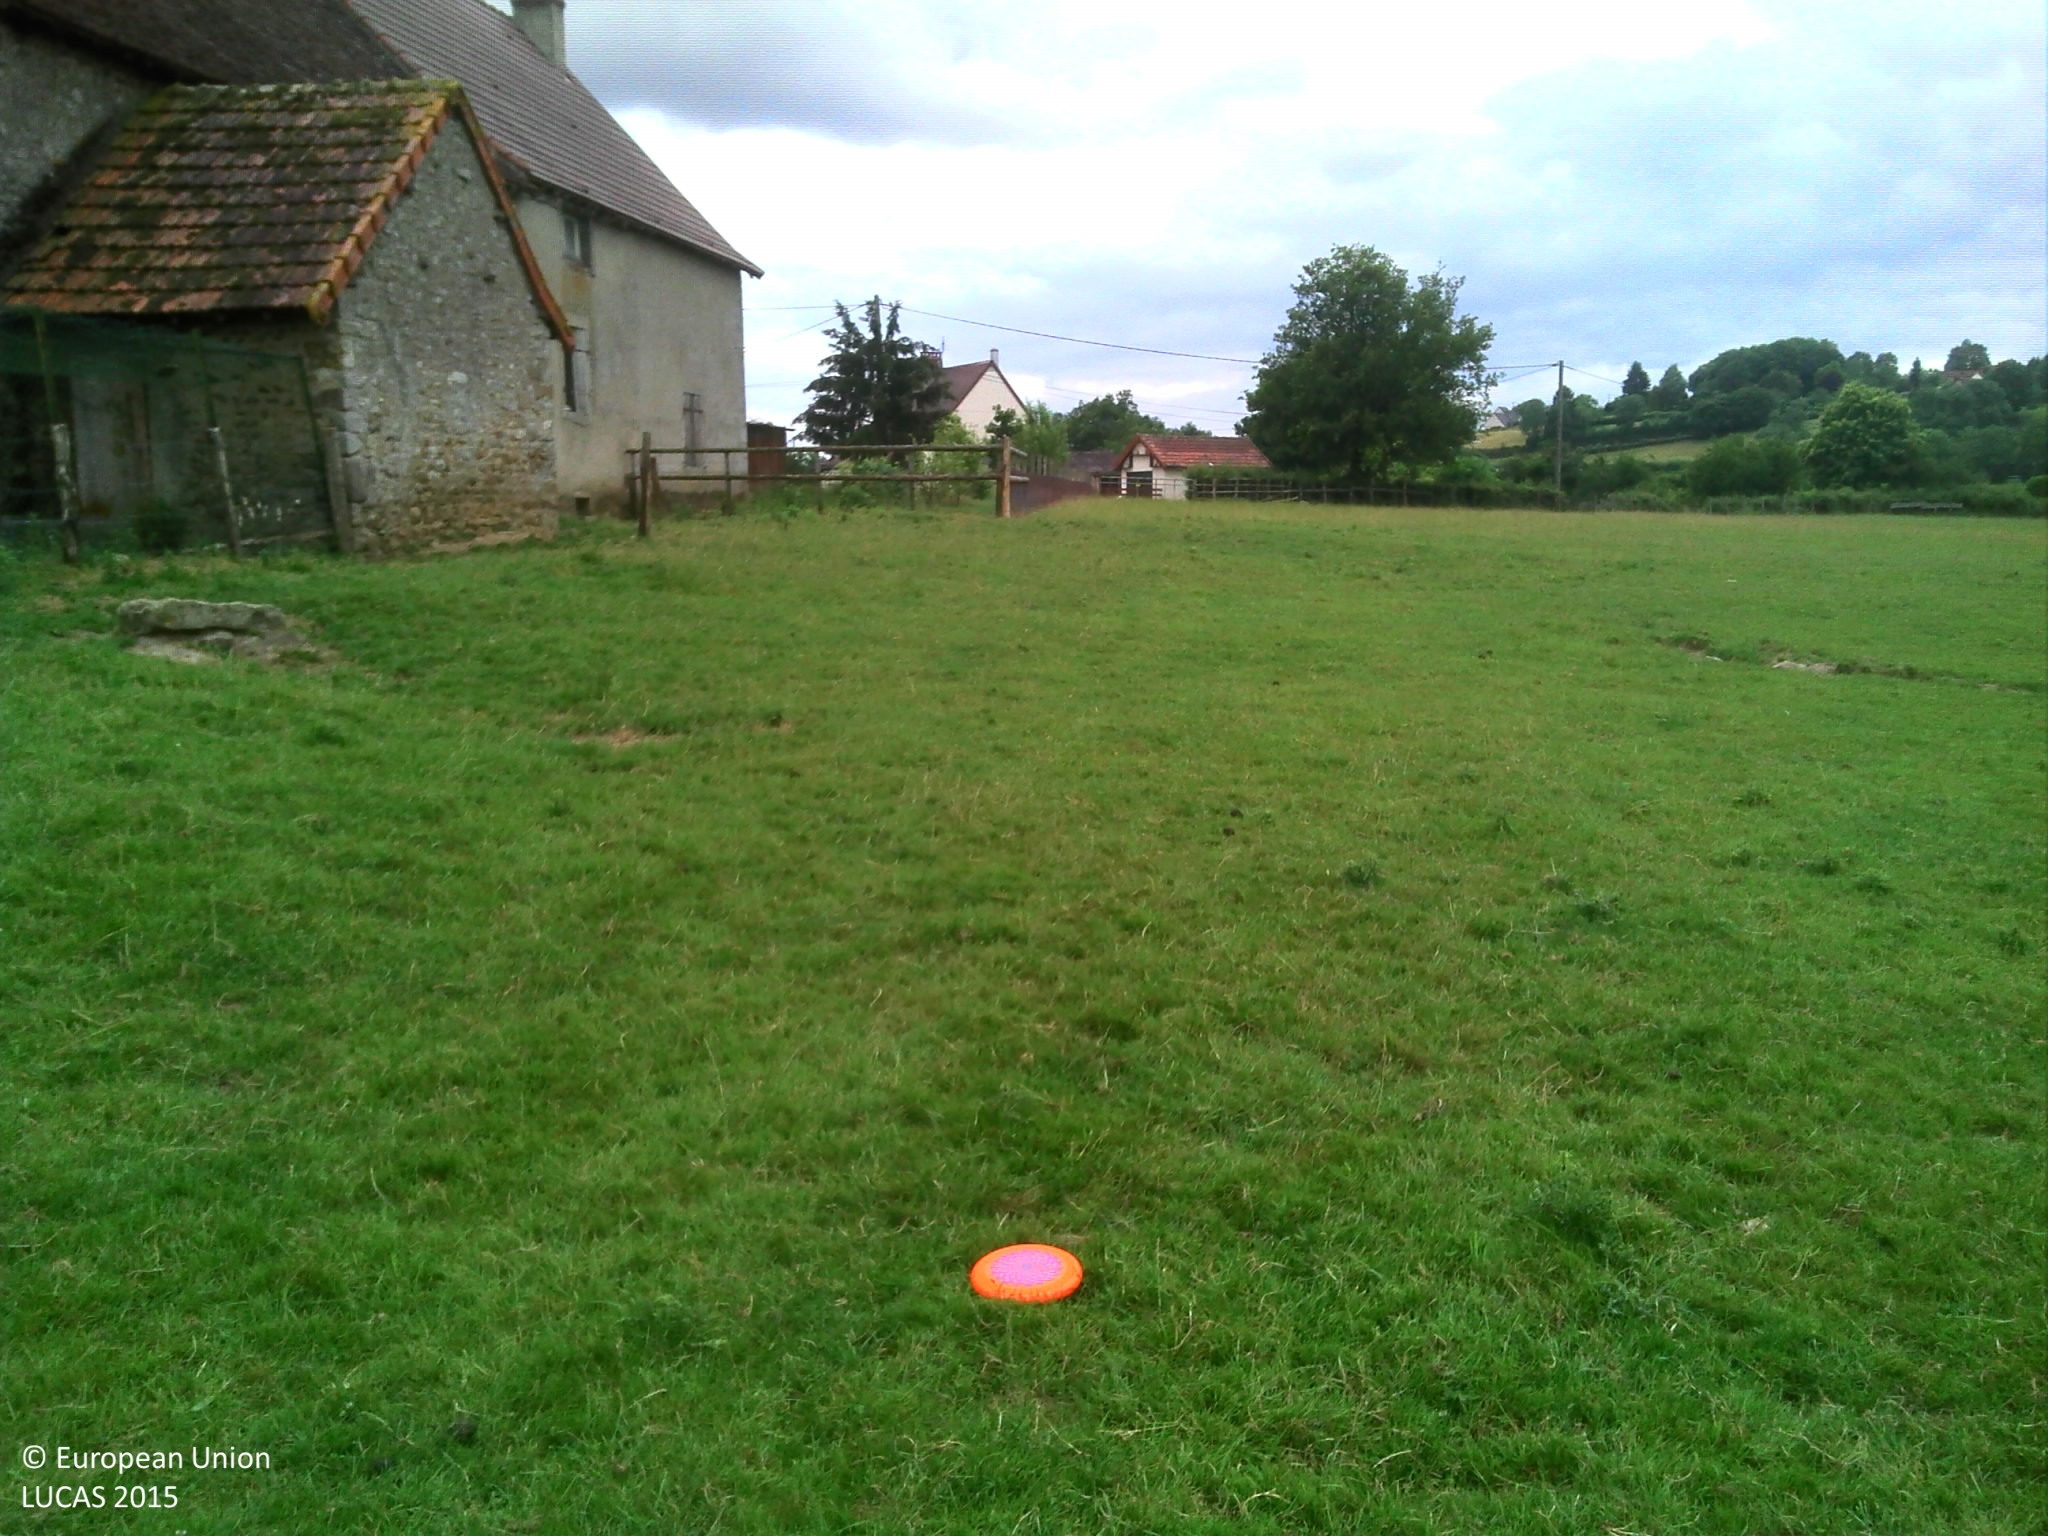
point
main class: Grassland
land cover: Grassland without tree/shrub cover
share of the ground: > 75 %
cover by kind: herbaceous plants 100 %
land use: Agriculture (excluding fallow land and kitchen gardens)
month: June
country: FR
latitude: 46.5505
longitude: 4.4581
